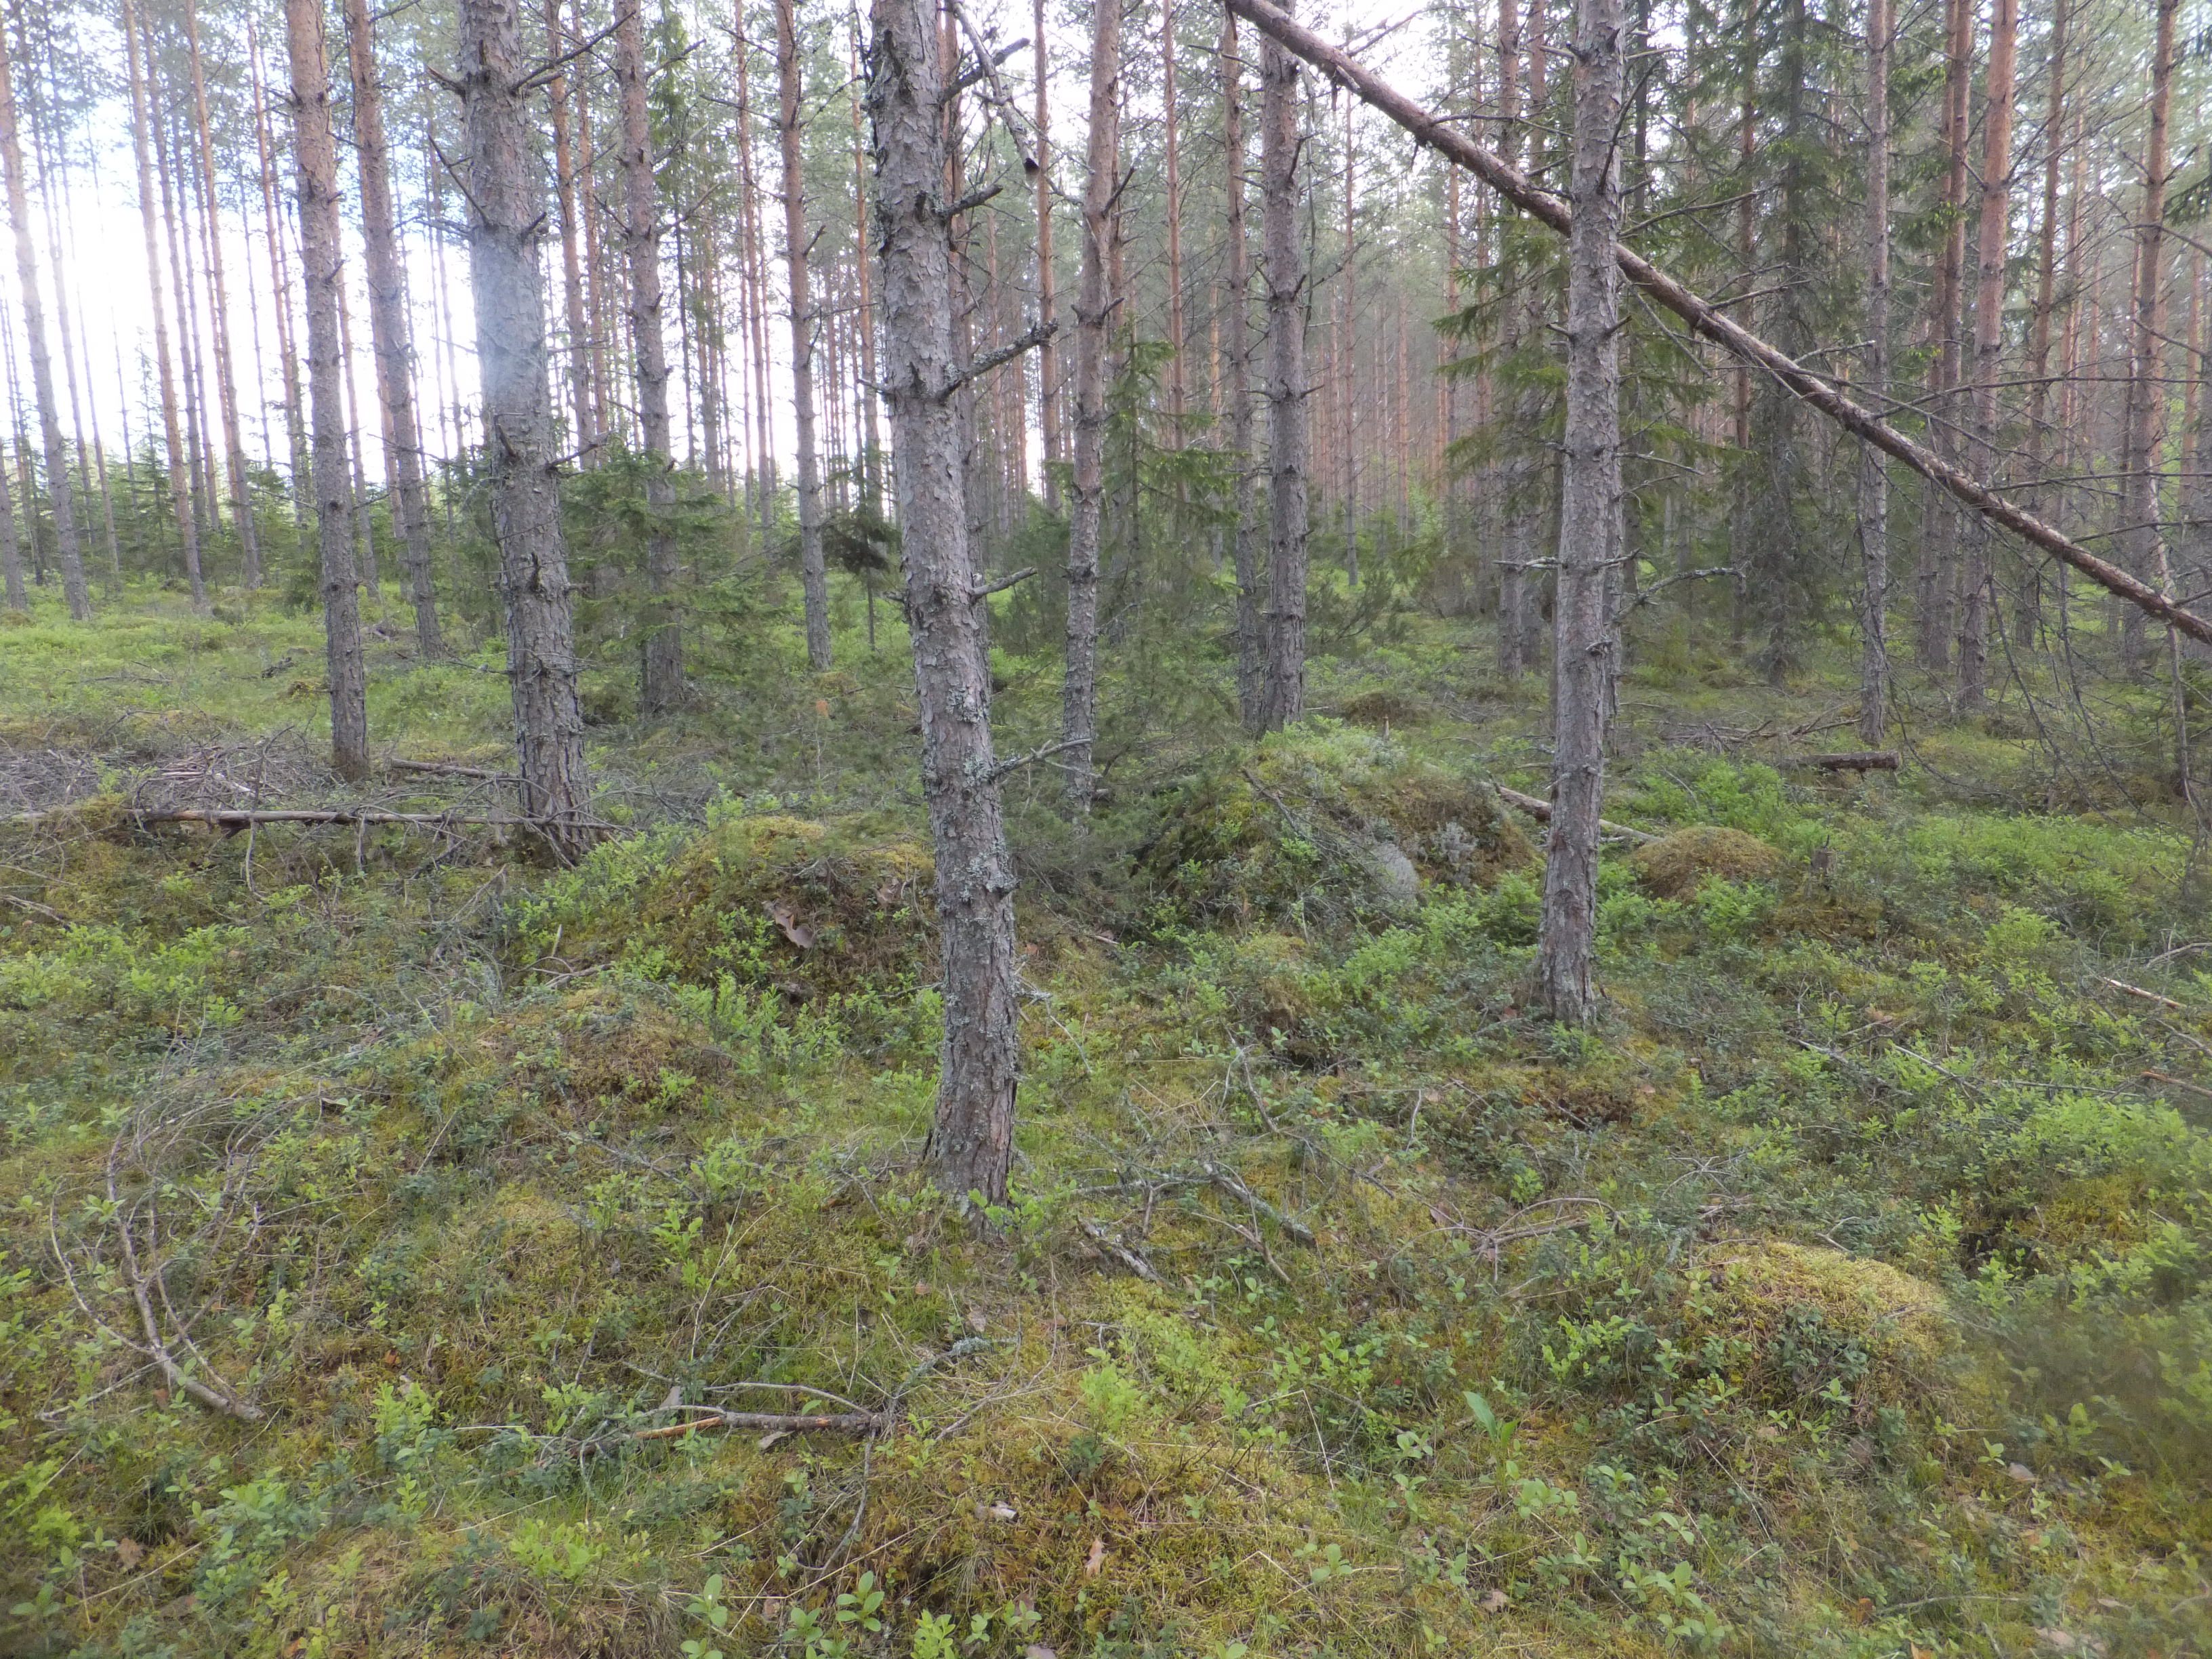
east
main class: Woodland
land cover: Pine dominated coniferous woodland
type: boreal forest
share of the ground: > 75 %
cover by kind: coniferous forest trees 90 %, shrubs 5 %, herbaceous plants 5 %
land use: Forestry
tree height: > 5 m
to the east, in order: Pine dominated coniferous woodland; Shrubland without tree cover; Lichens and moss; Pine dominated coniferous woodland
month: June
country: FI
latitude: 63.4941
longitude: 23.2122
